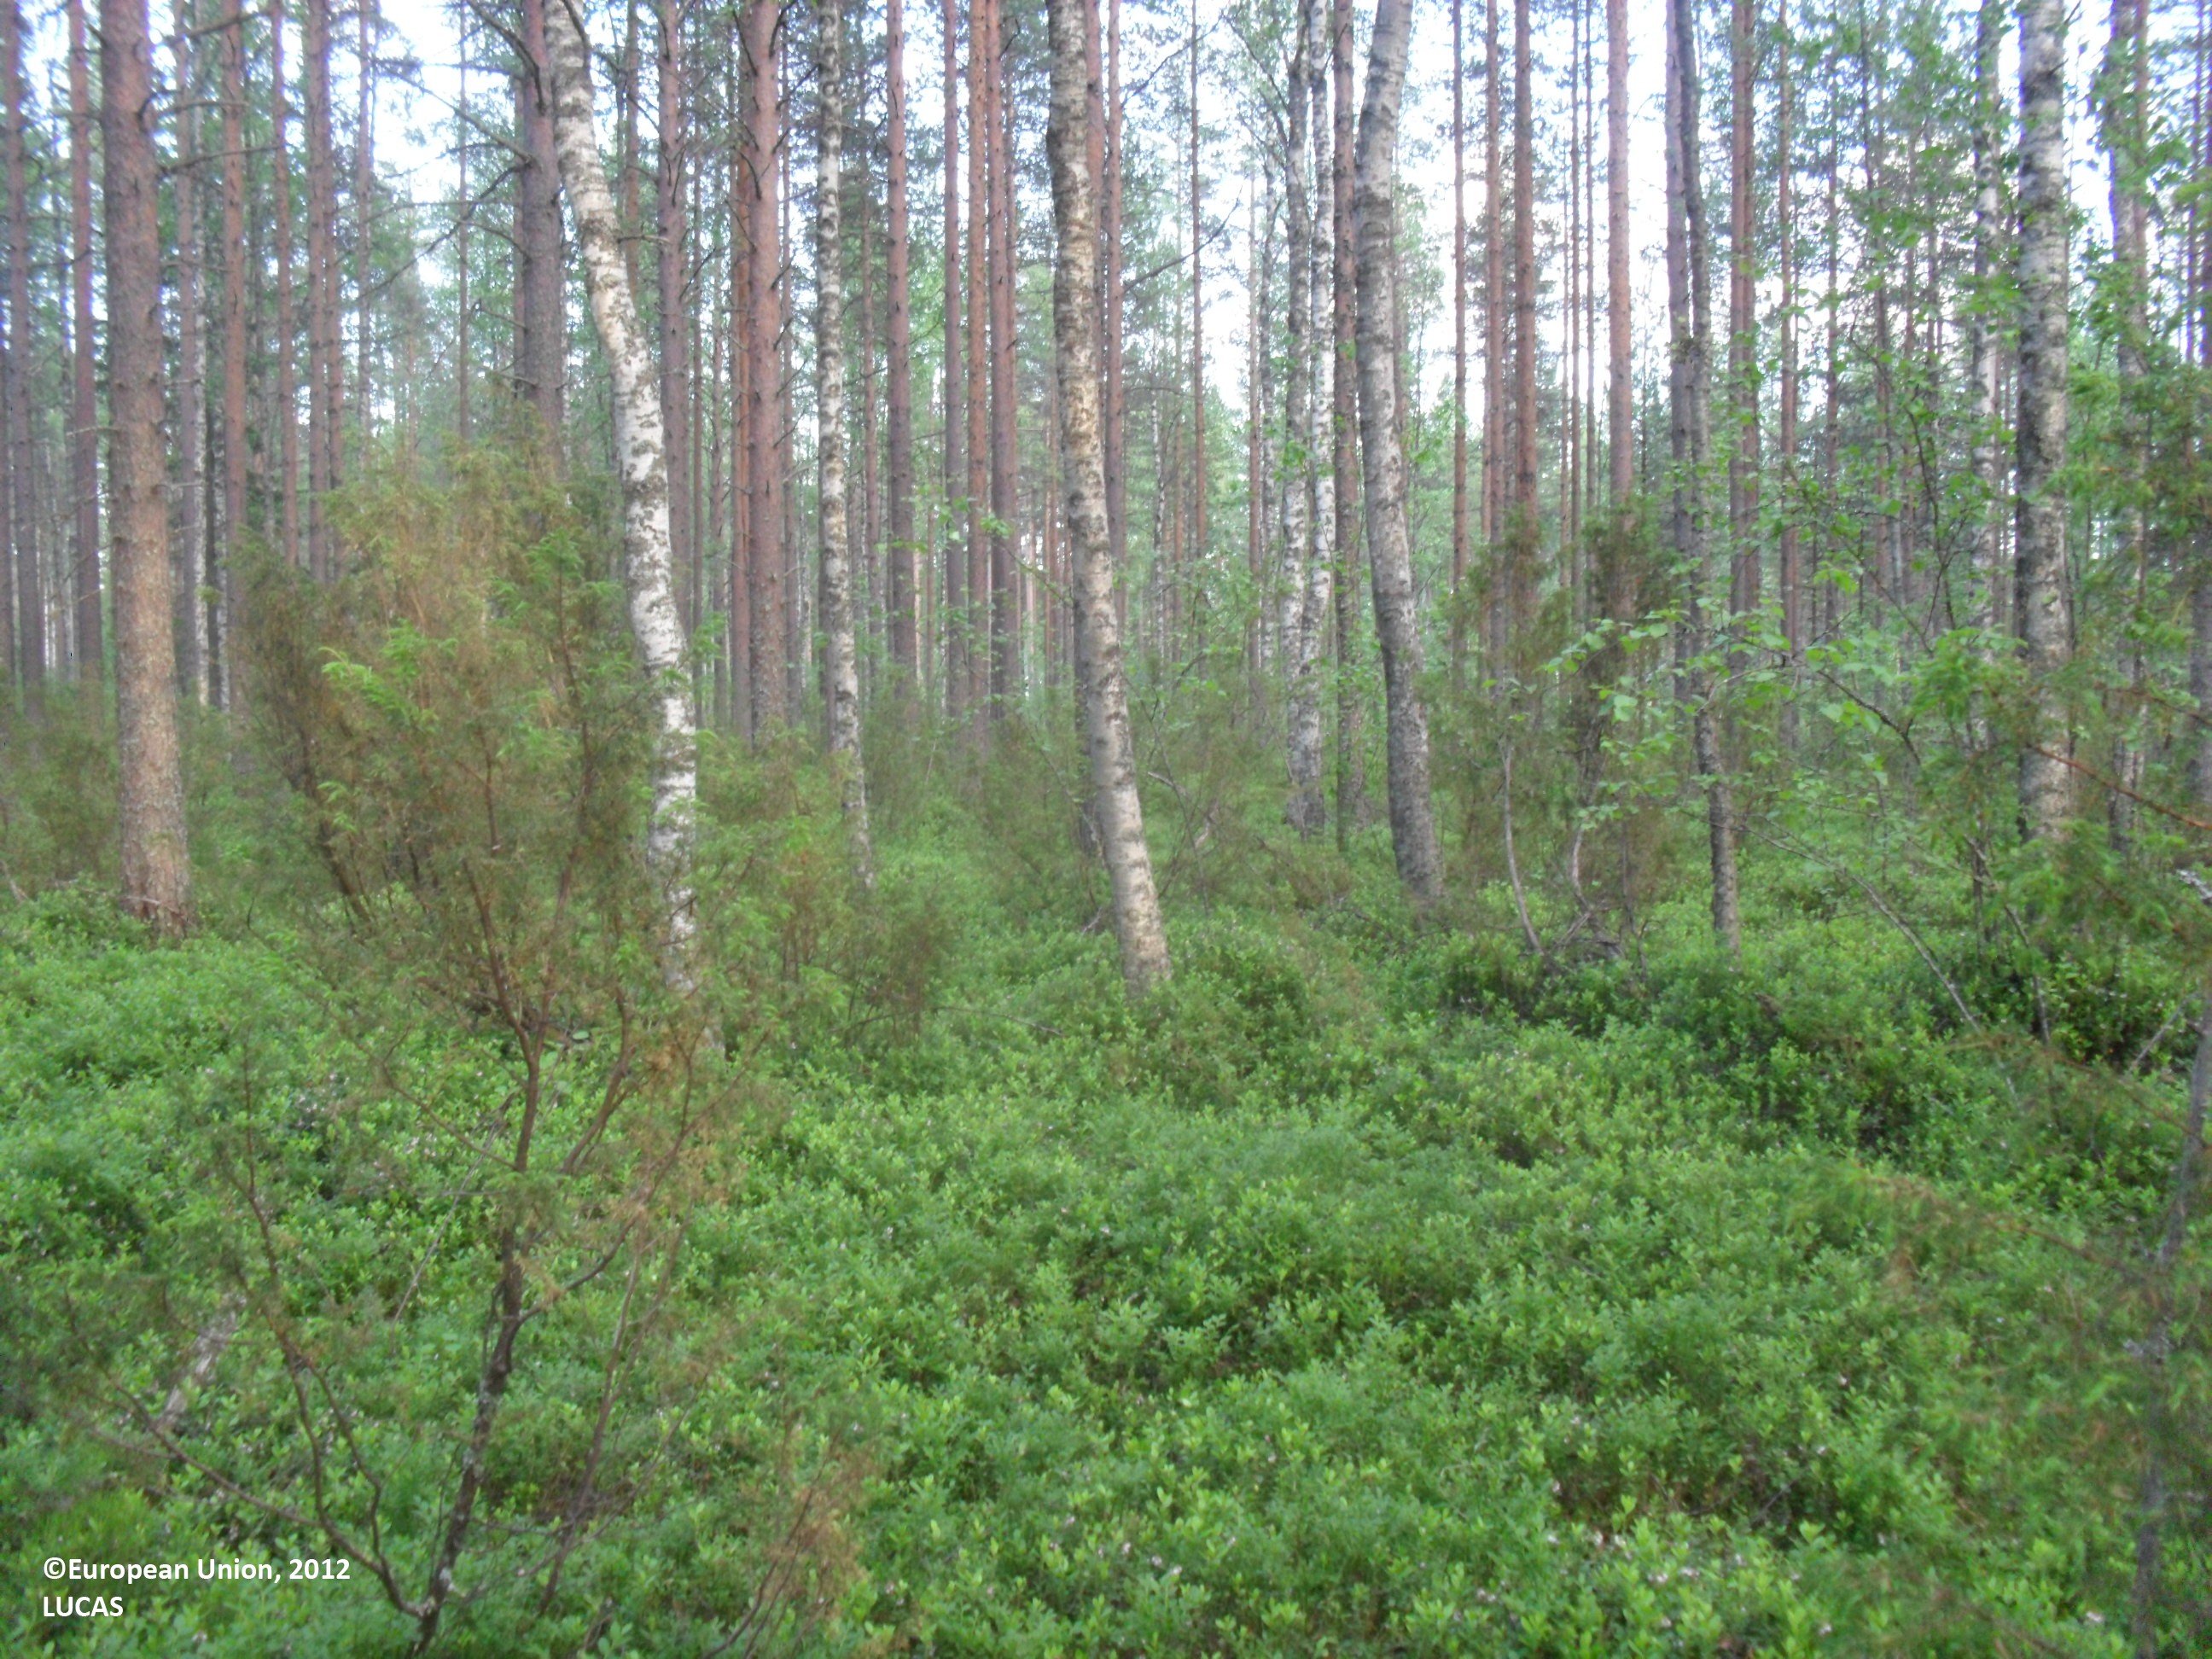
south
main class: Woodland
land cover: Other mixed woodland
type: boreal forest
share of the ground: 50 - 75 %
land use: Forestry
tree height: > 5 m
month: July
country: FI
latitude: 63.0467
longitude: 24.2989
